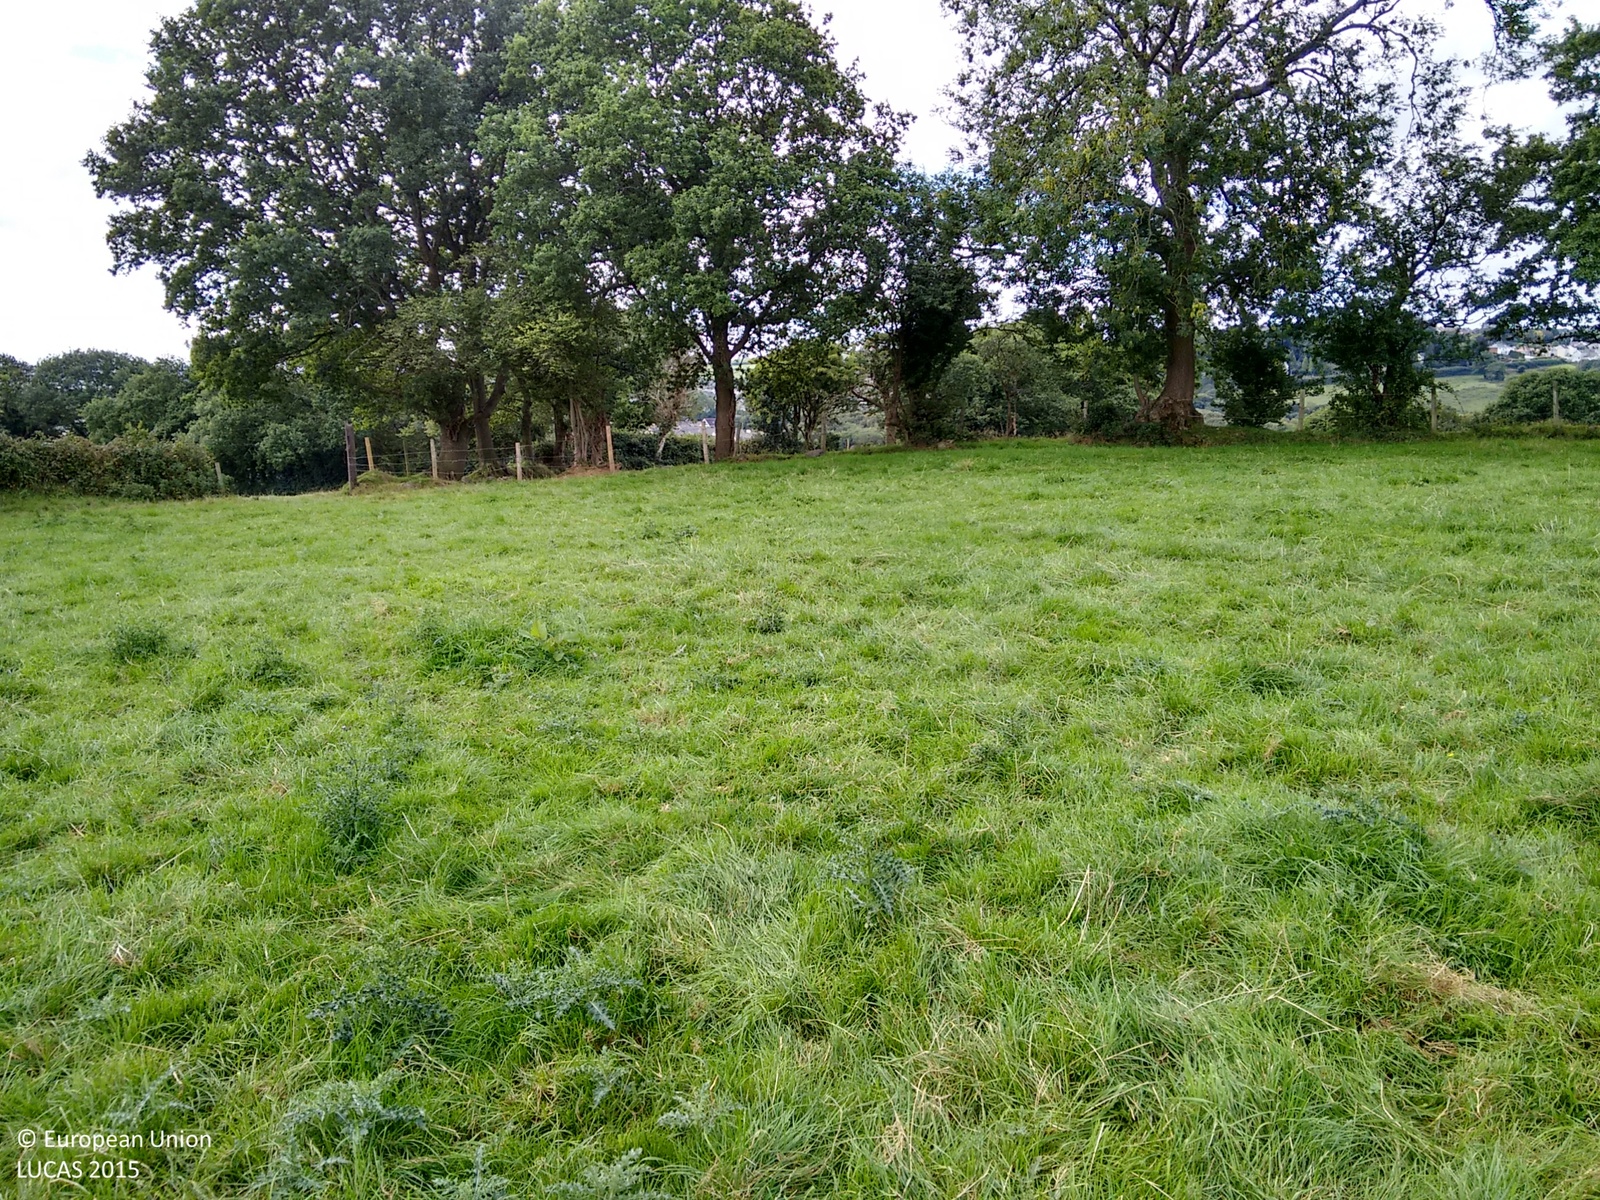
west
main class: Grassland
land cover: Grassland without tree/shrub cover
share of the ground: > 75 %
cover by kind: herbaceous plants 100 %
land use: Agriculture (excluding fallow land and kitchen gardens)
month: September
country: GB
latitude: 51.7206
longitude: -4.0354
